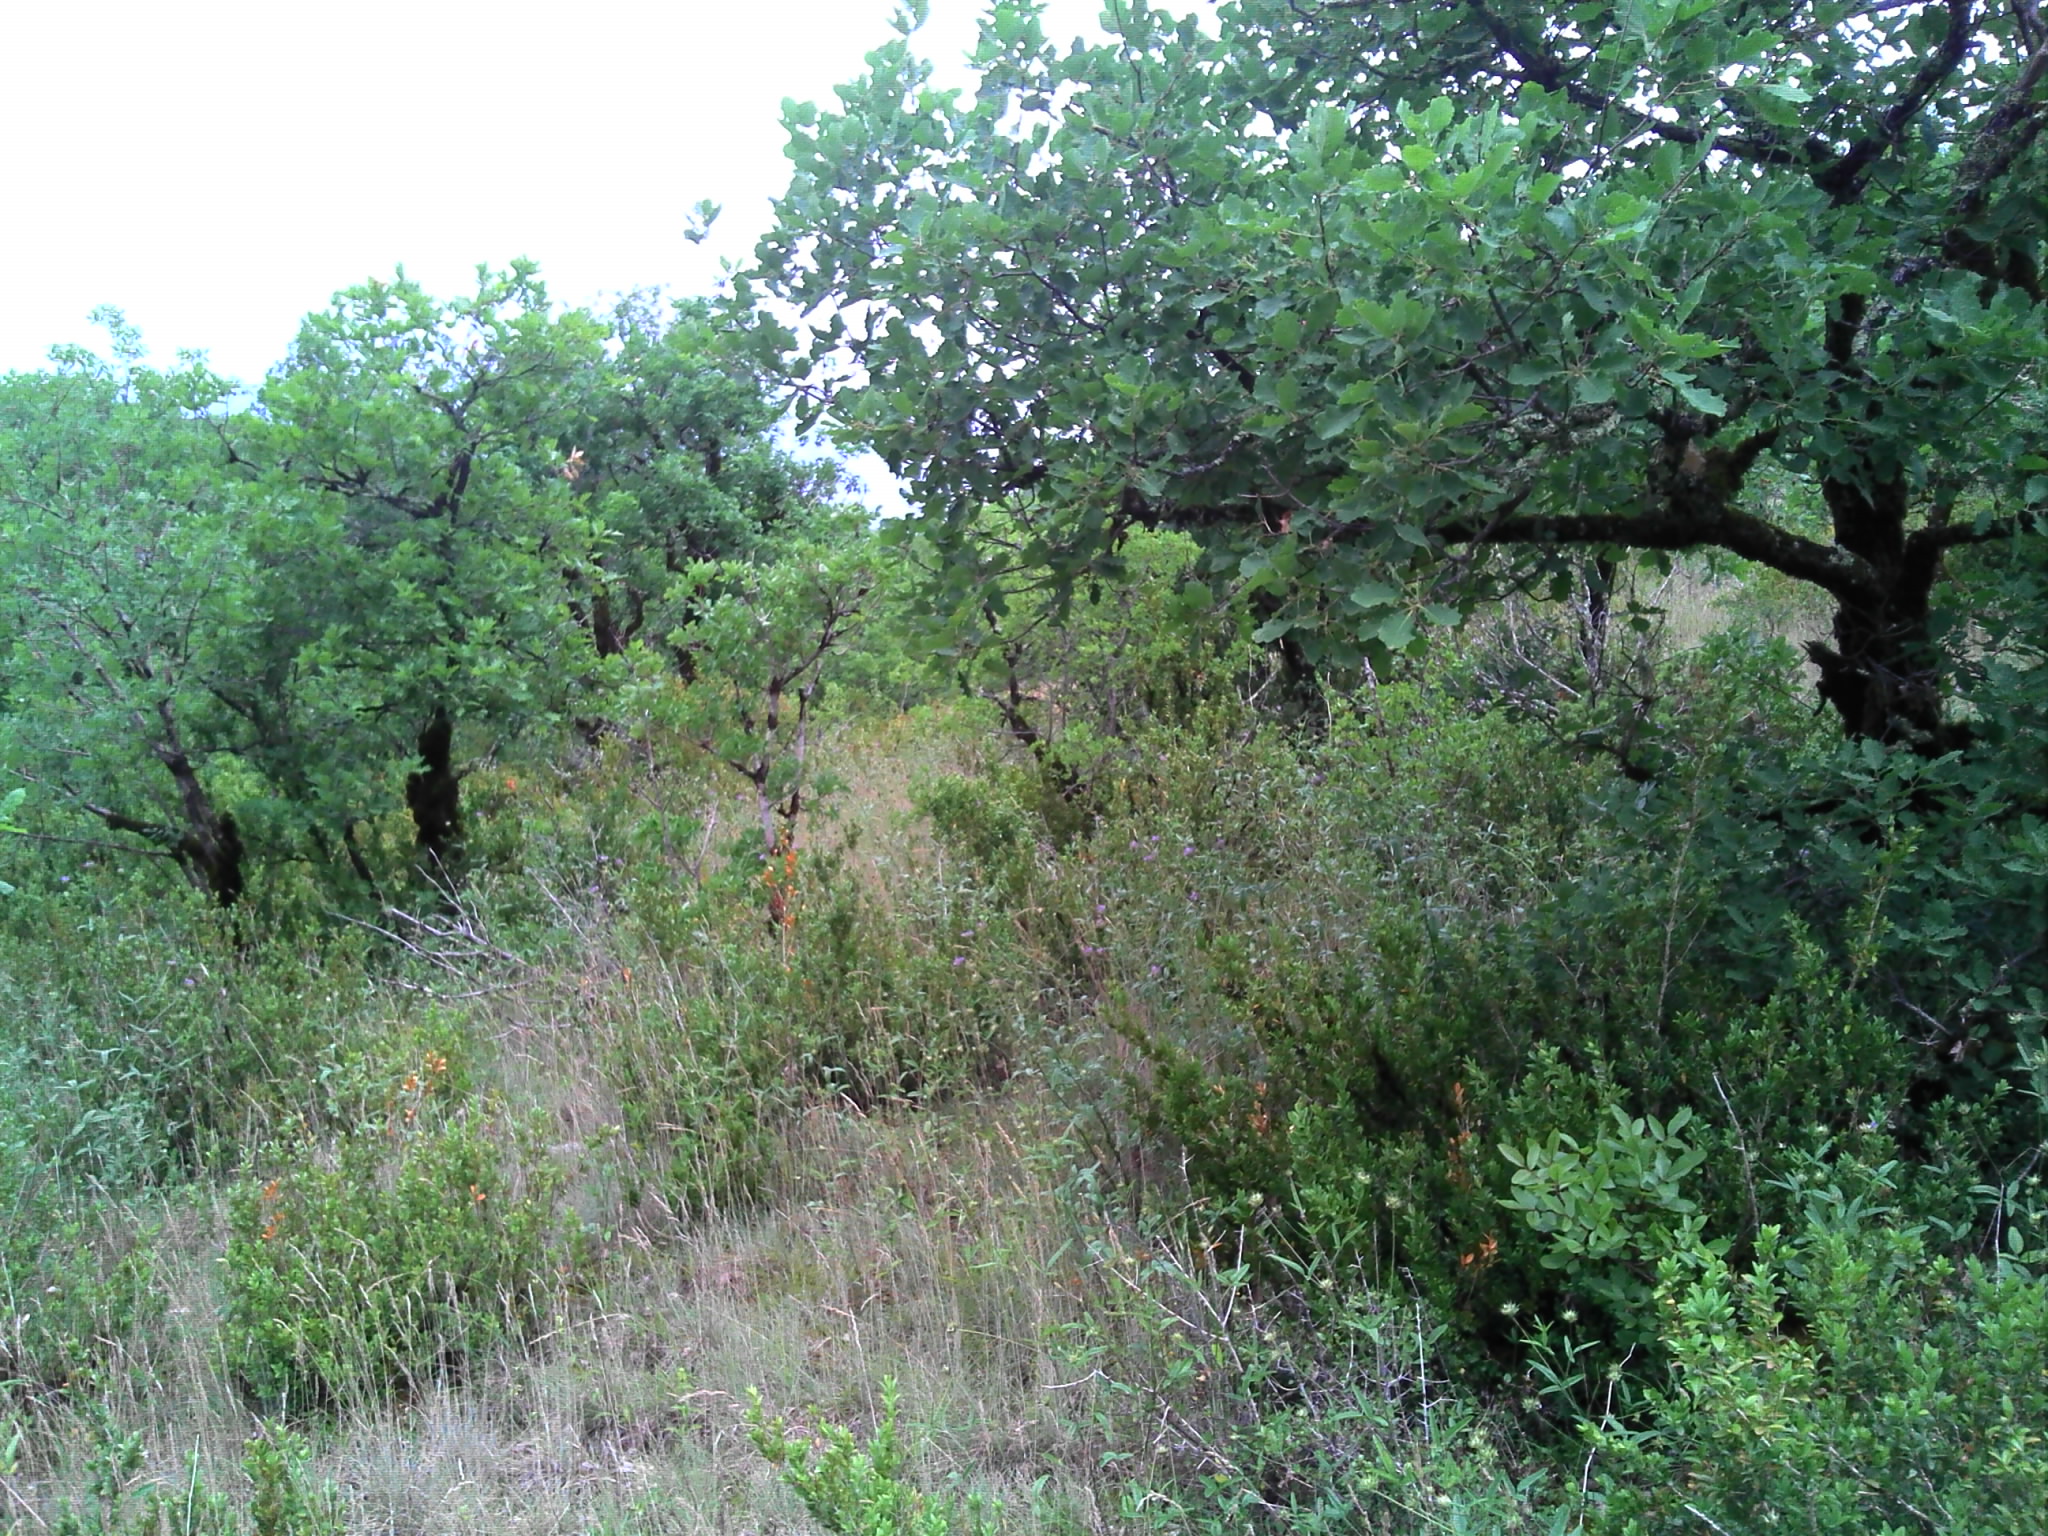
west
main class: Woodland
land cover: Broadleaved woodland
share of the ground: > 75 %
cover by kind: broadleaved forest trees 95 %, herbaceous plants 5 %
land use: Semi-natural and natural areas not in use
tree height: < 5 m
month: June
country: FR
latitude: 44.4378
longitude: 1.5182
